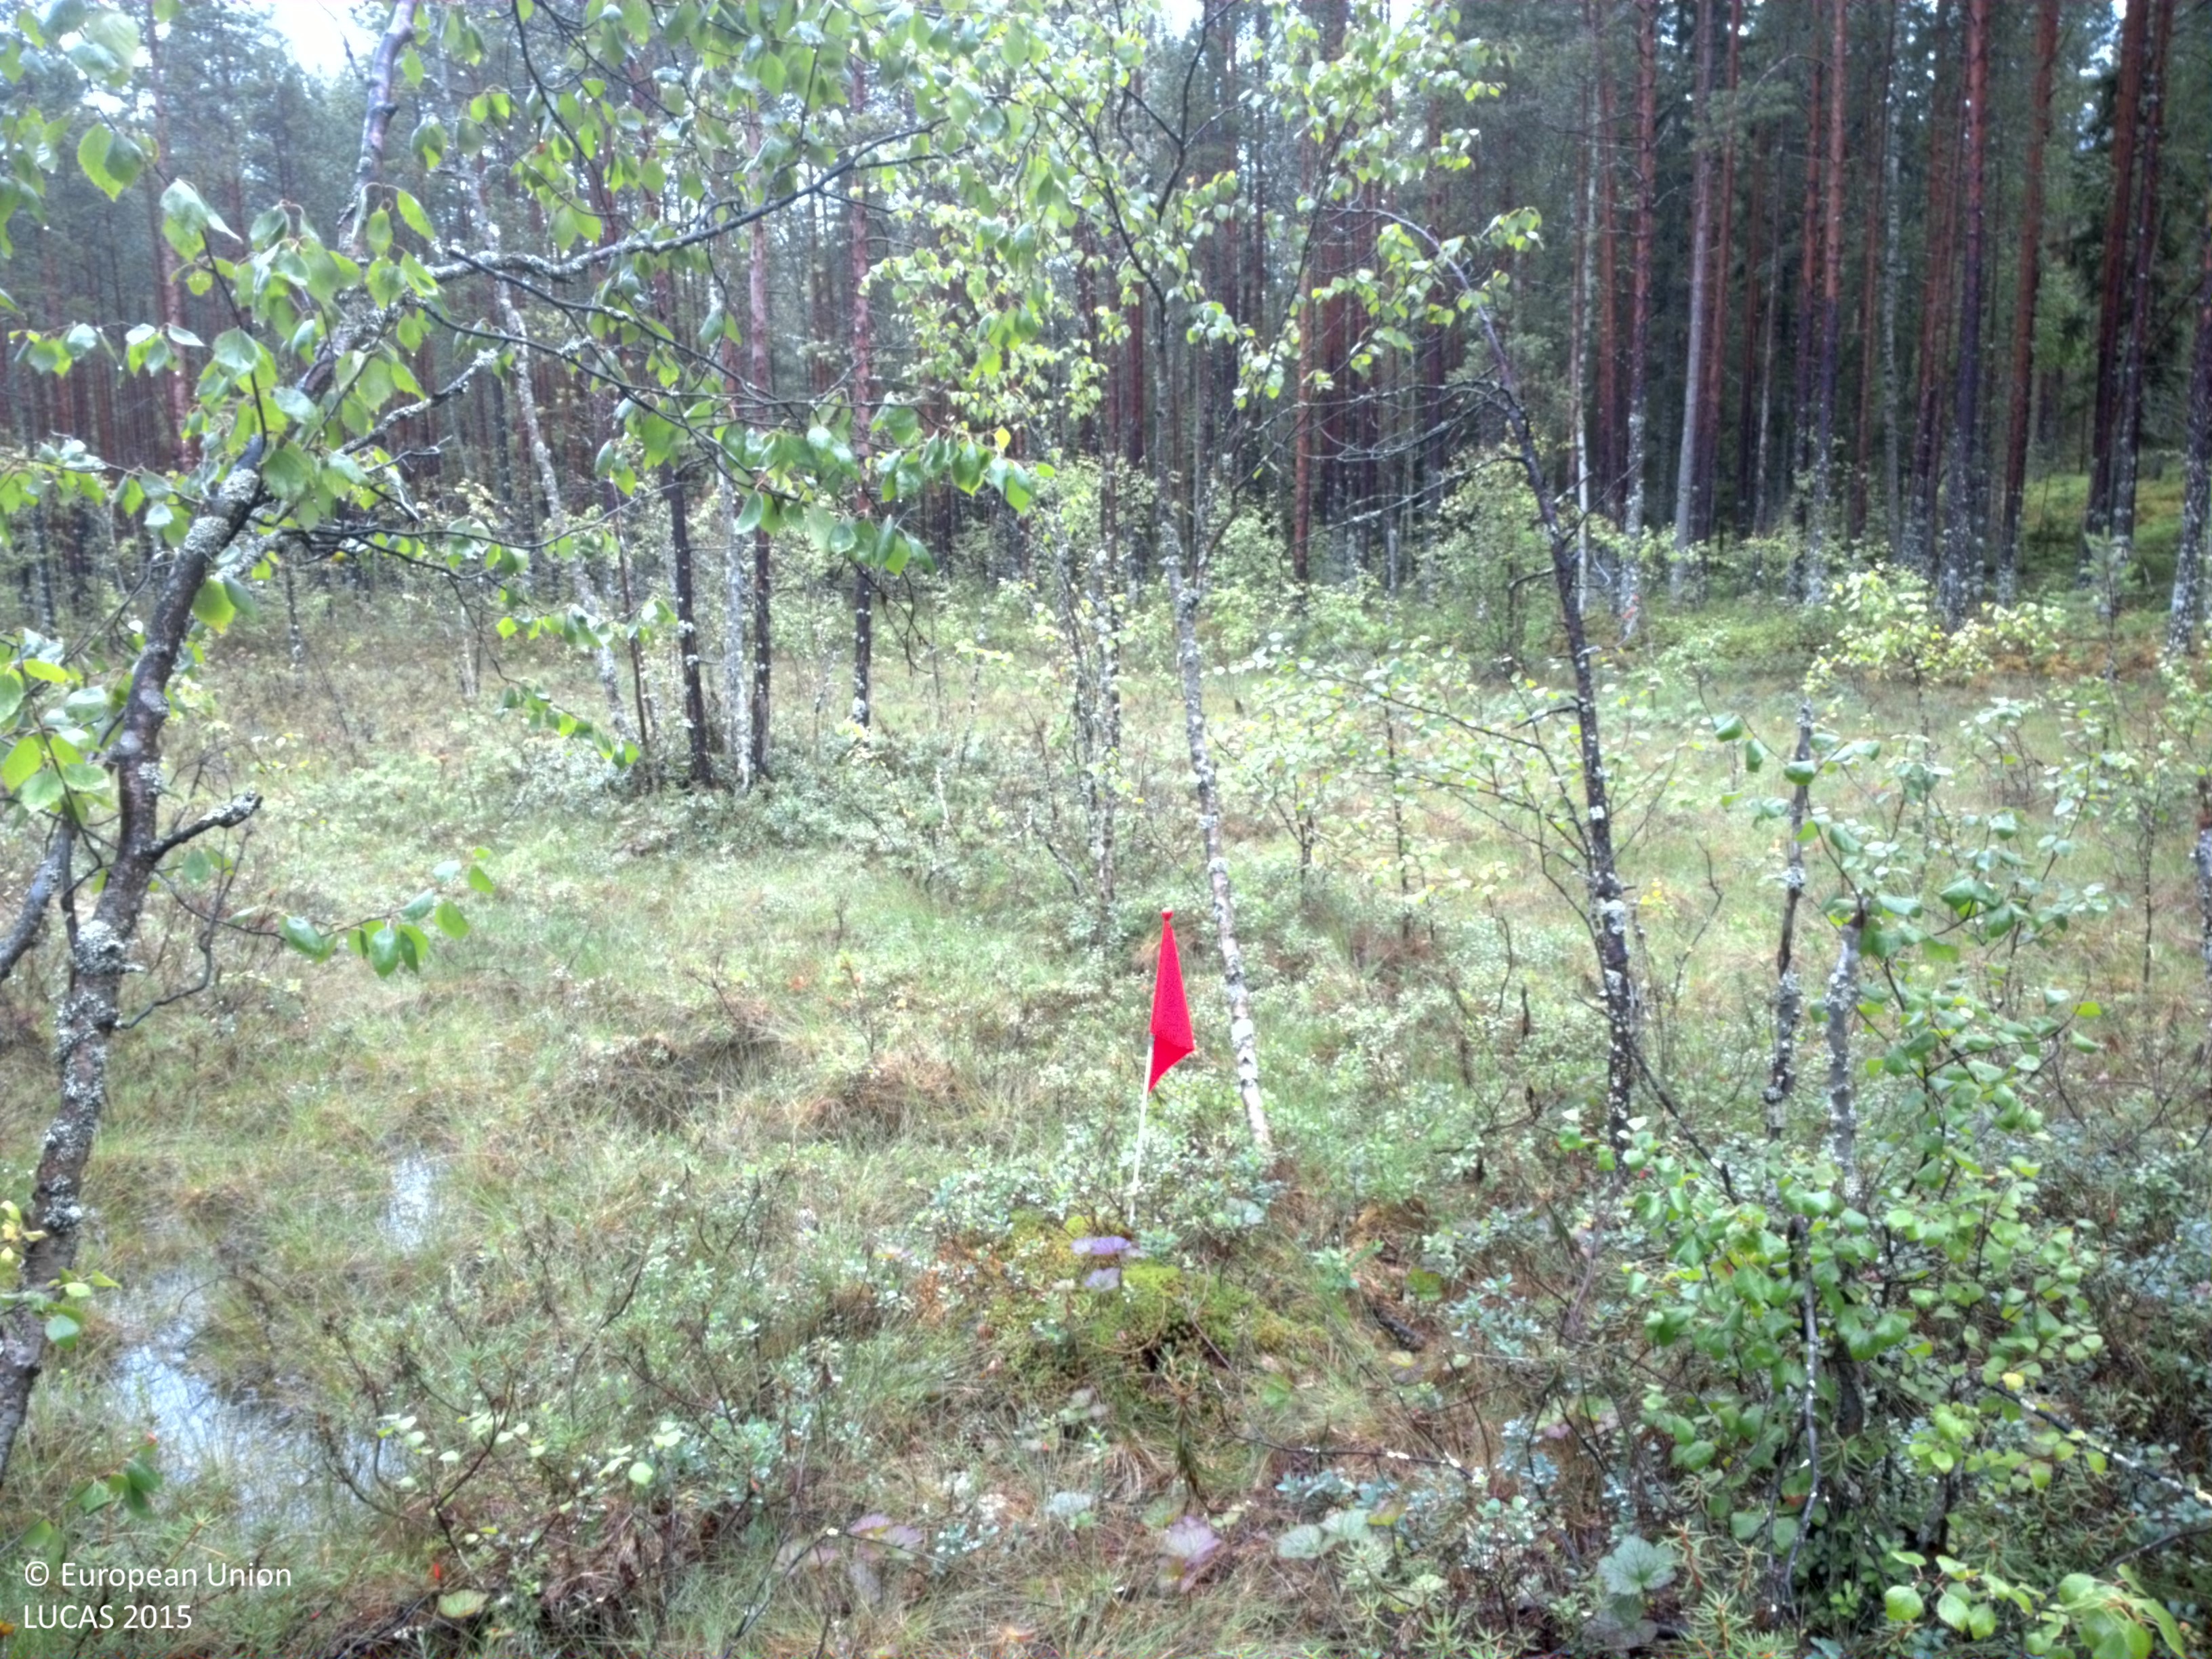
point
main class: Woodland
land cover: Other mixed woodland
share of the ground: 25 - 50 %
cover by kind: herbaceous plants 40 %, coniferous forest trees 20 %, broadleaved forest trees 20 %, shrubs 20 %
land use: Semi-natural and natural areas not in use
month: August
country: SE
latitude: 64.6713
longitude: 21.0198
